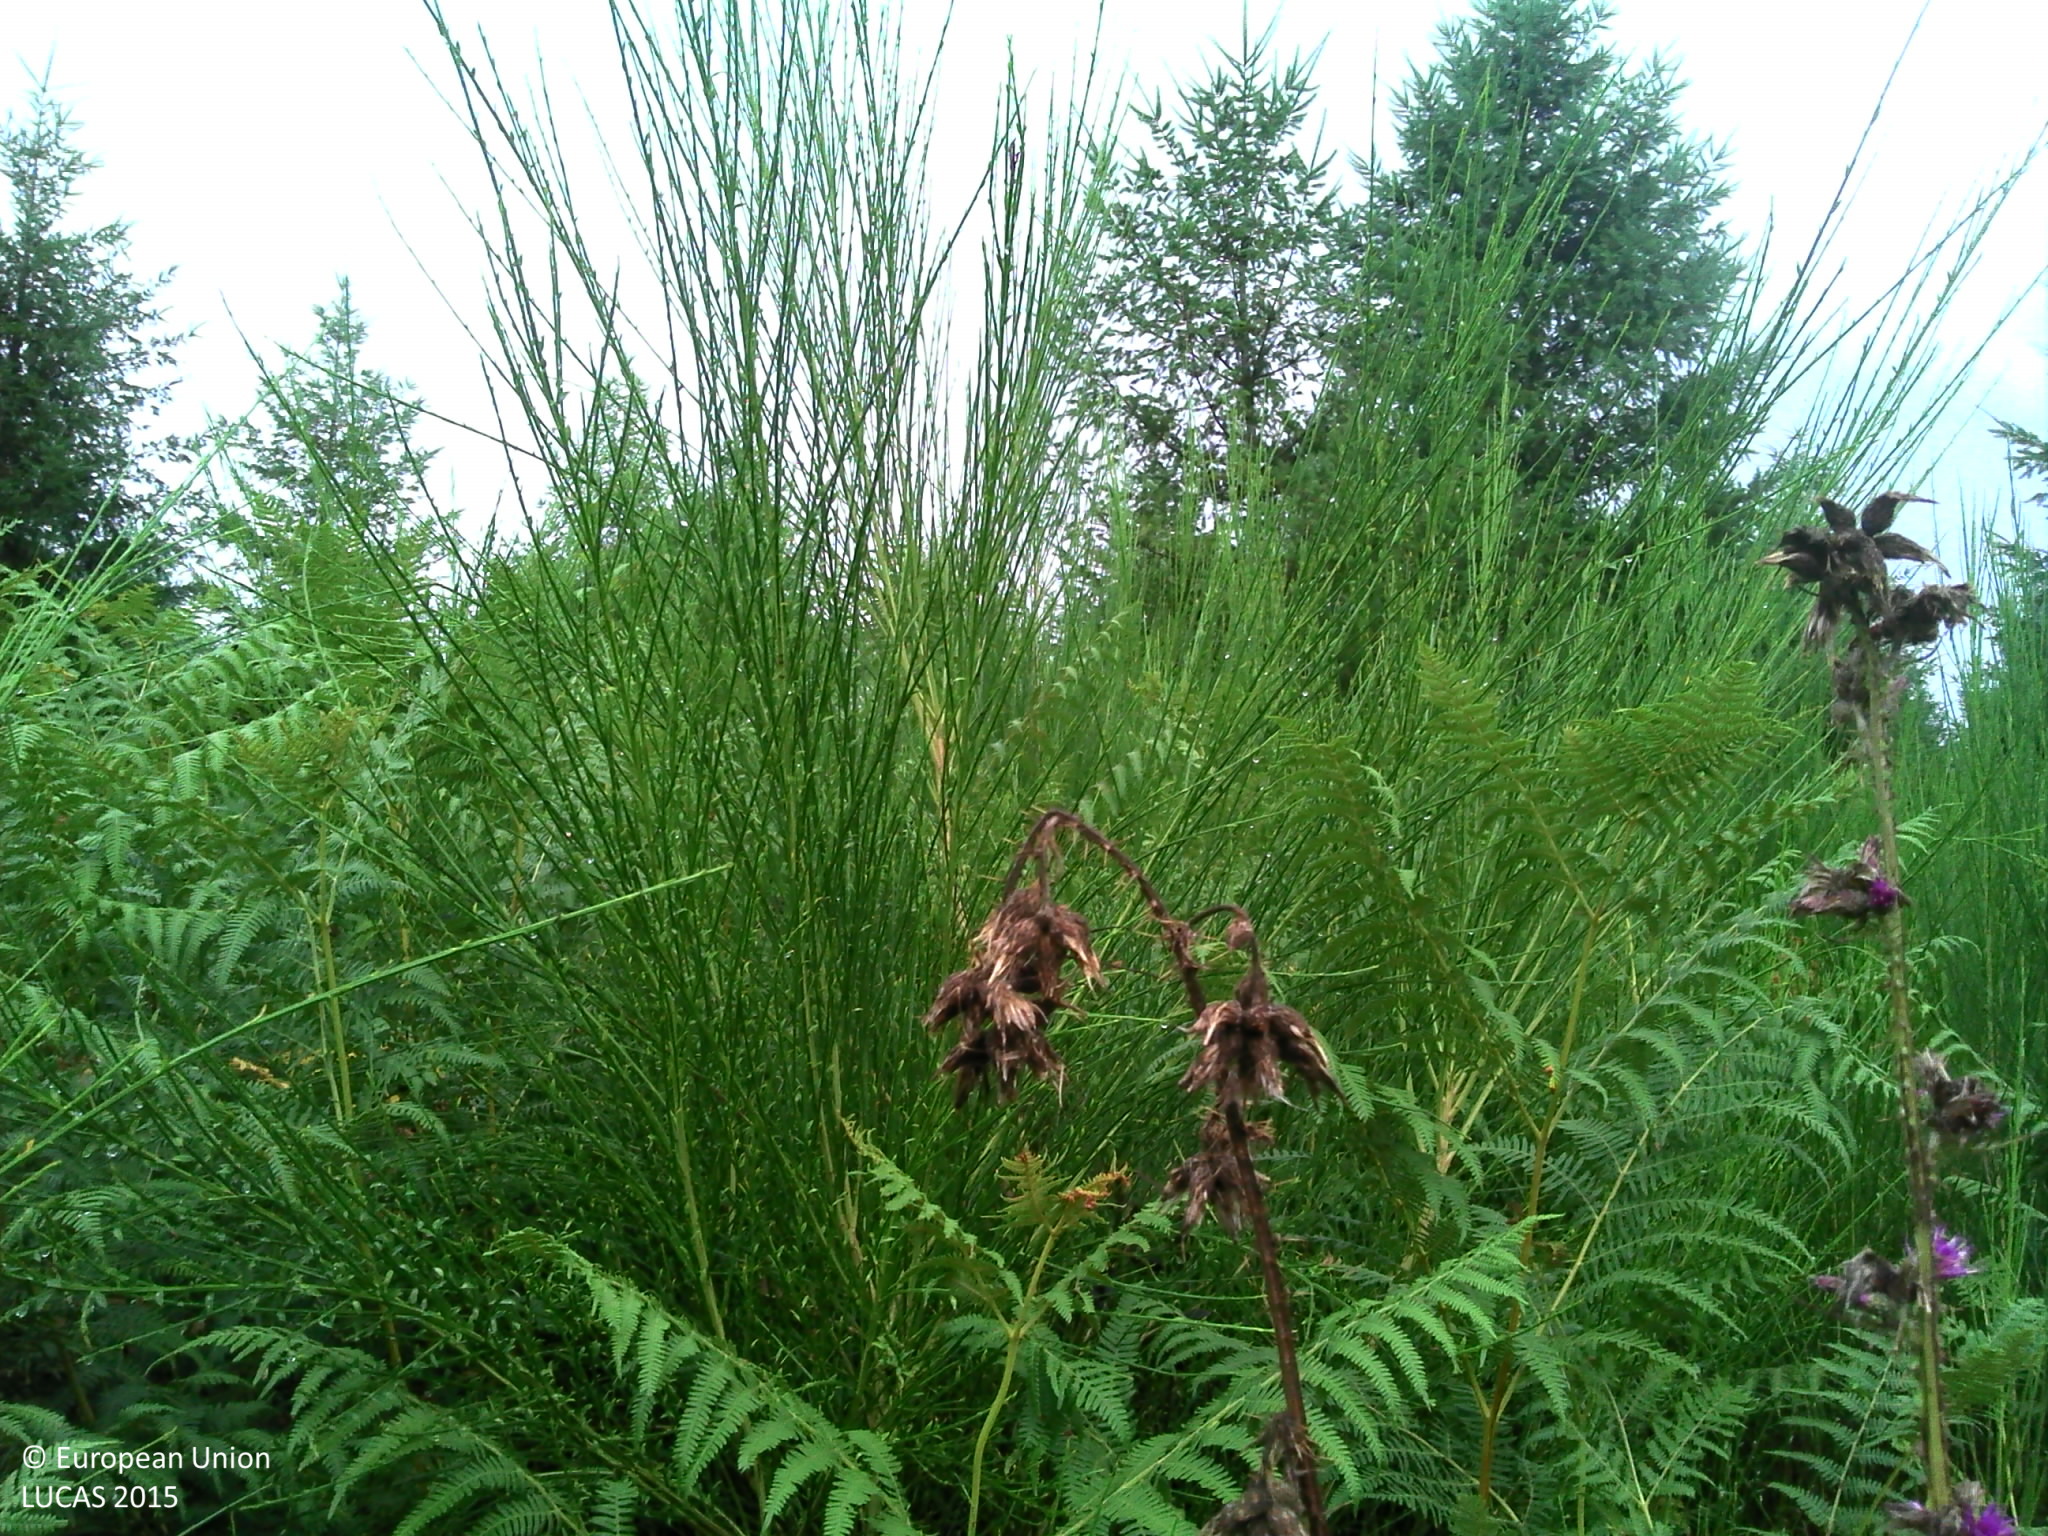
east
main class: Woodland
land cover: Spruce dominated coniferous woodland
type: exotic forest
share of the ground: 25 - 50 %
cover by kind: herbaceous plants 40 %, coniferous forest trees 30 %, shrubs 15 %, lichens and mosses 10 %, broadleaved forest trees 5 %
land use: Forestry
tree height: > 5 m
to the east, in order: Spruce dominated coniferous woodland; Grass margins; Ditches and canals; Grass margins; Paved roads, cycling and walking lanes; Grass margins; Broadleaved woodland; Grass margins; Paved roads, cycling and walking lanes; Grassland with sparse tree/shrub cover; Paved roads, cycling and walking lanes; Grass margins; Ditches and canals; Grass margins; Maize
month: August
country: FR
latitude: 45.5396
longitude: 1.0388
